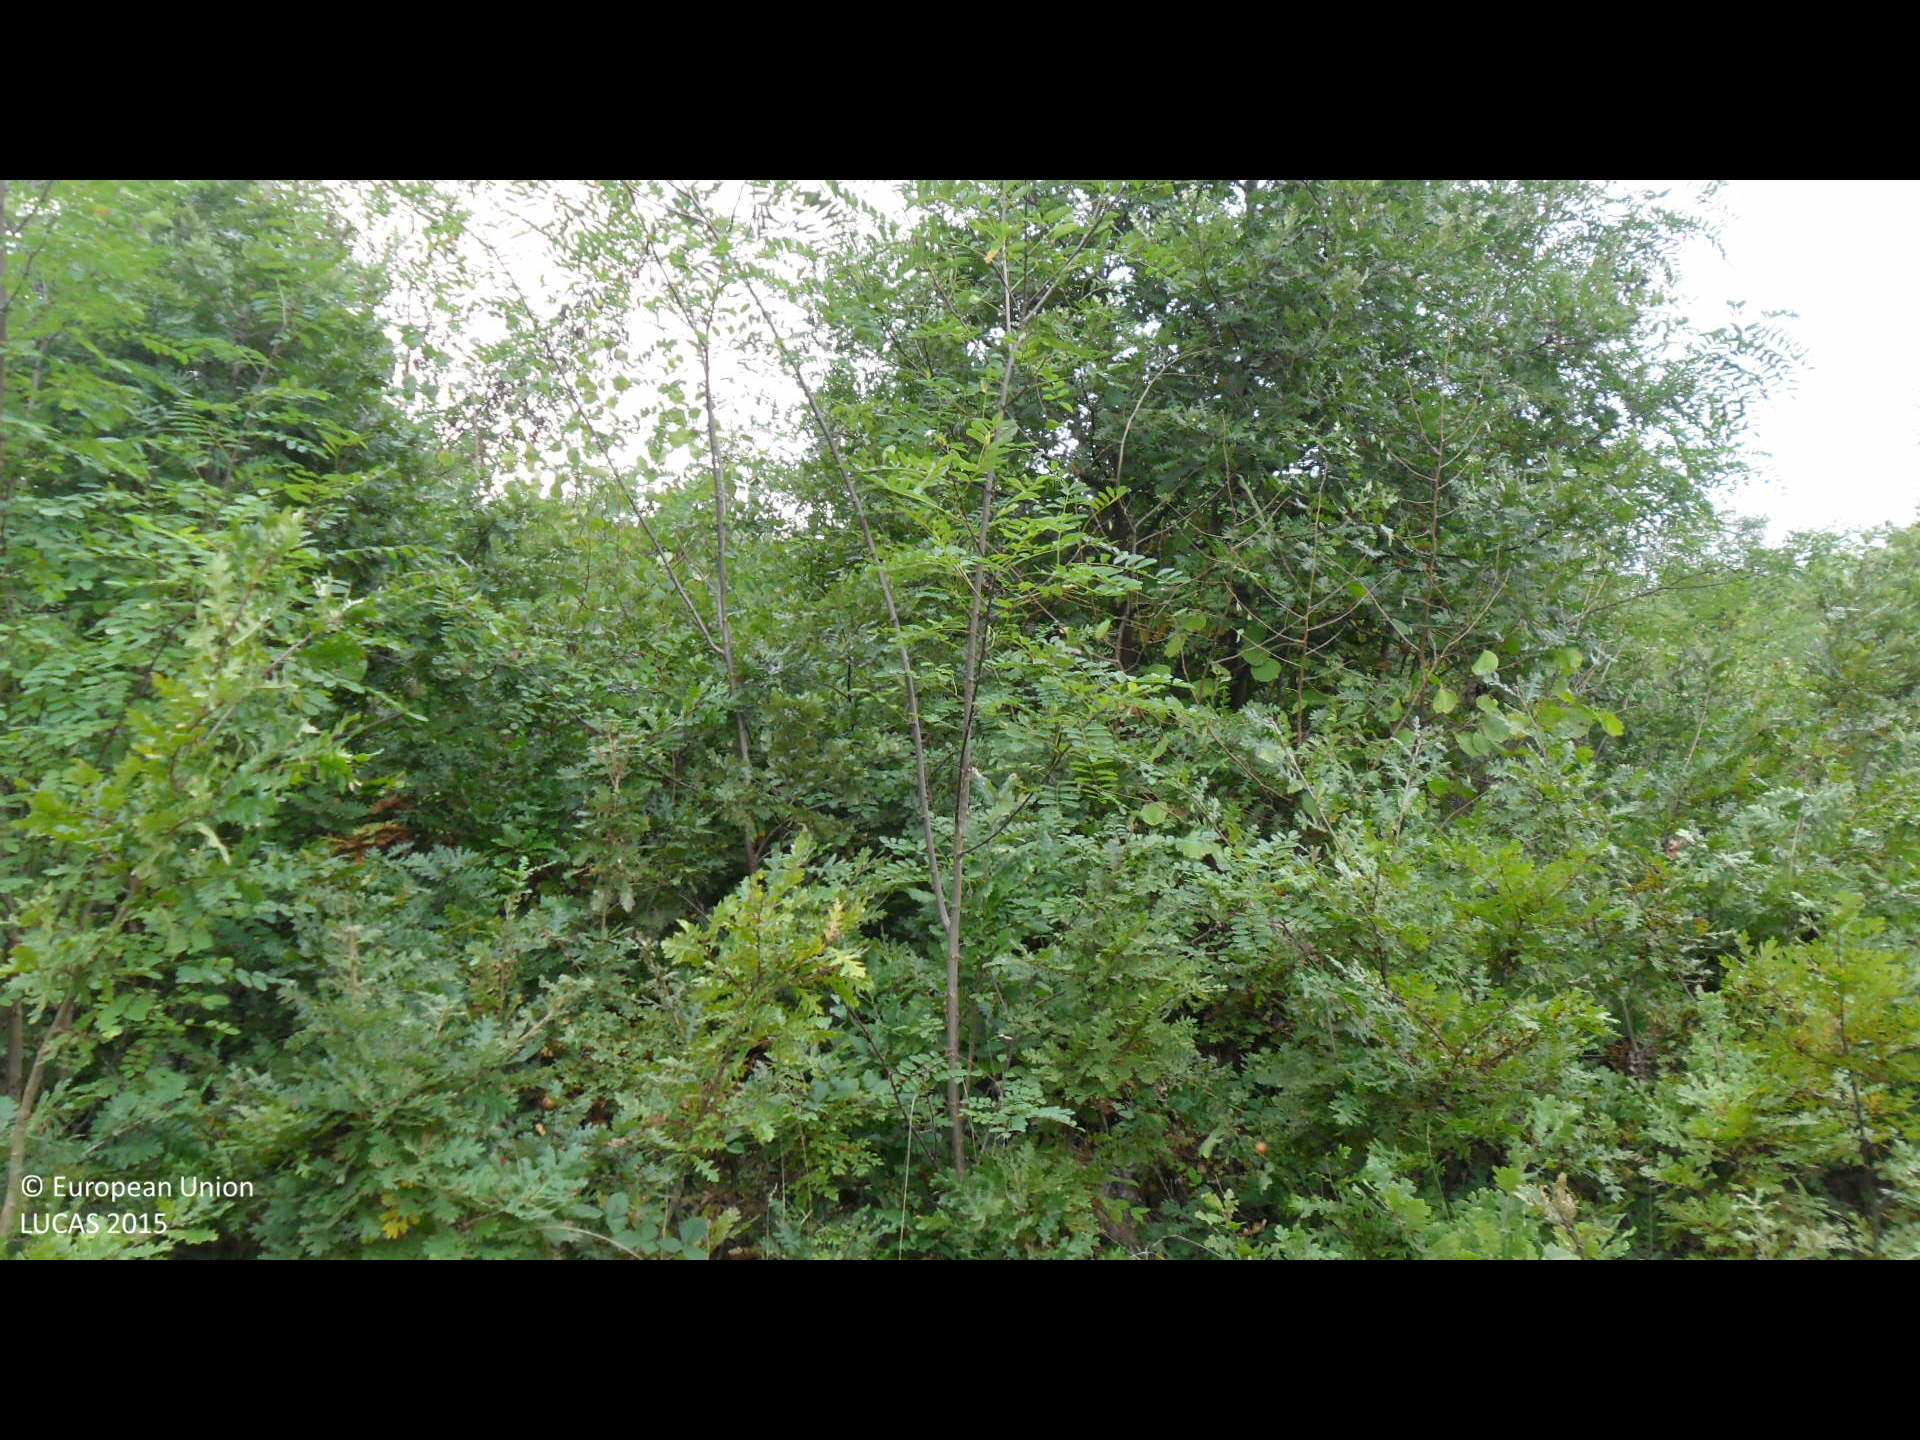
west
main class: Woodland
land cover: Broadleaved woodland
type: mesophytic deciduous forest
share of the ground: > 75 %
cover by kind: broadleaved forest trees 95 %, unconsolidated bare surface 5 %
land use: Forestry
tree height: > 5 m
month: September
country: BG
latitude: 43.1136
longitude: 26.2547
